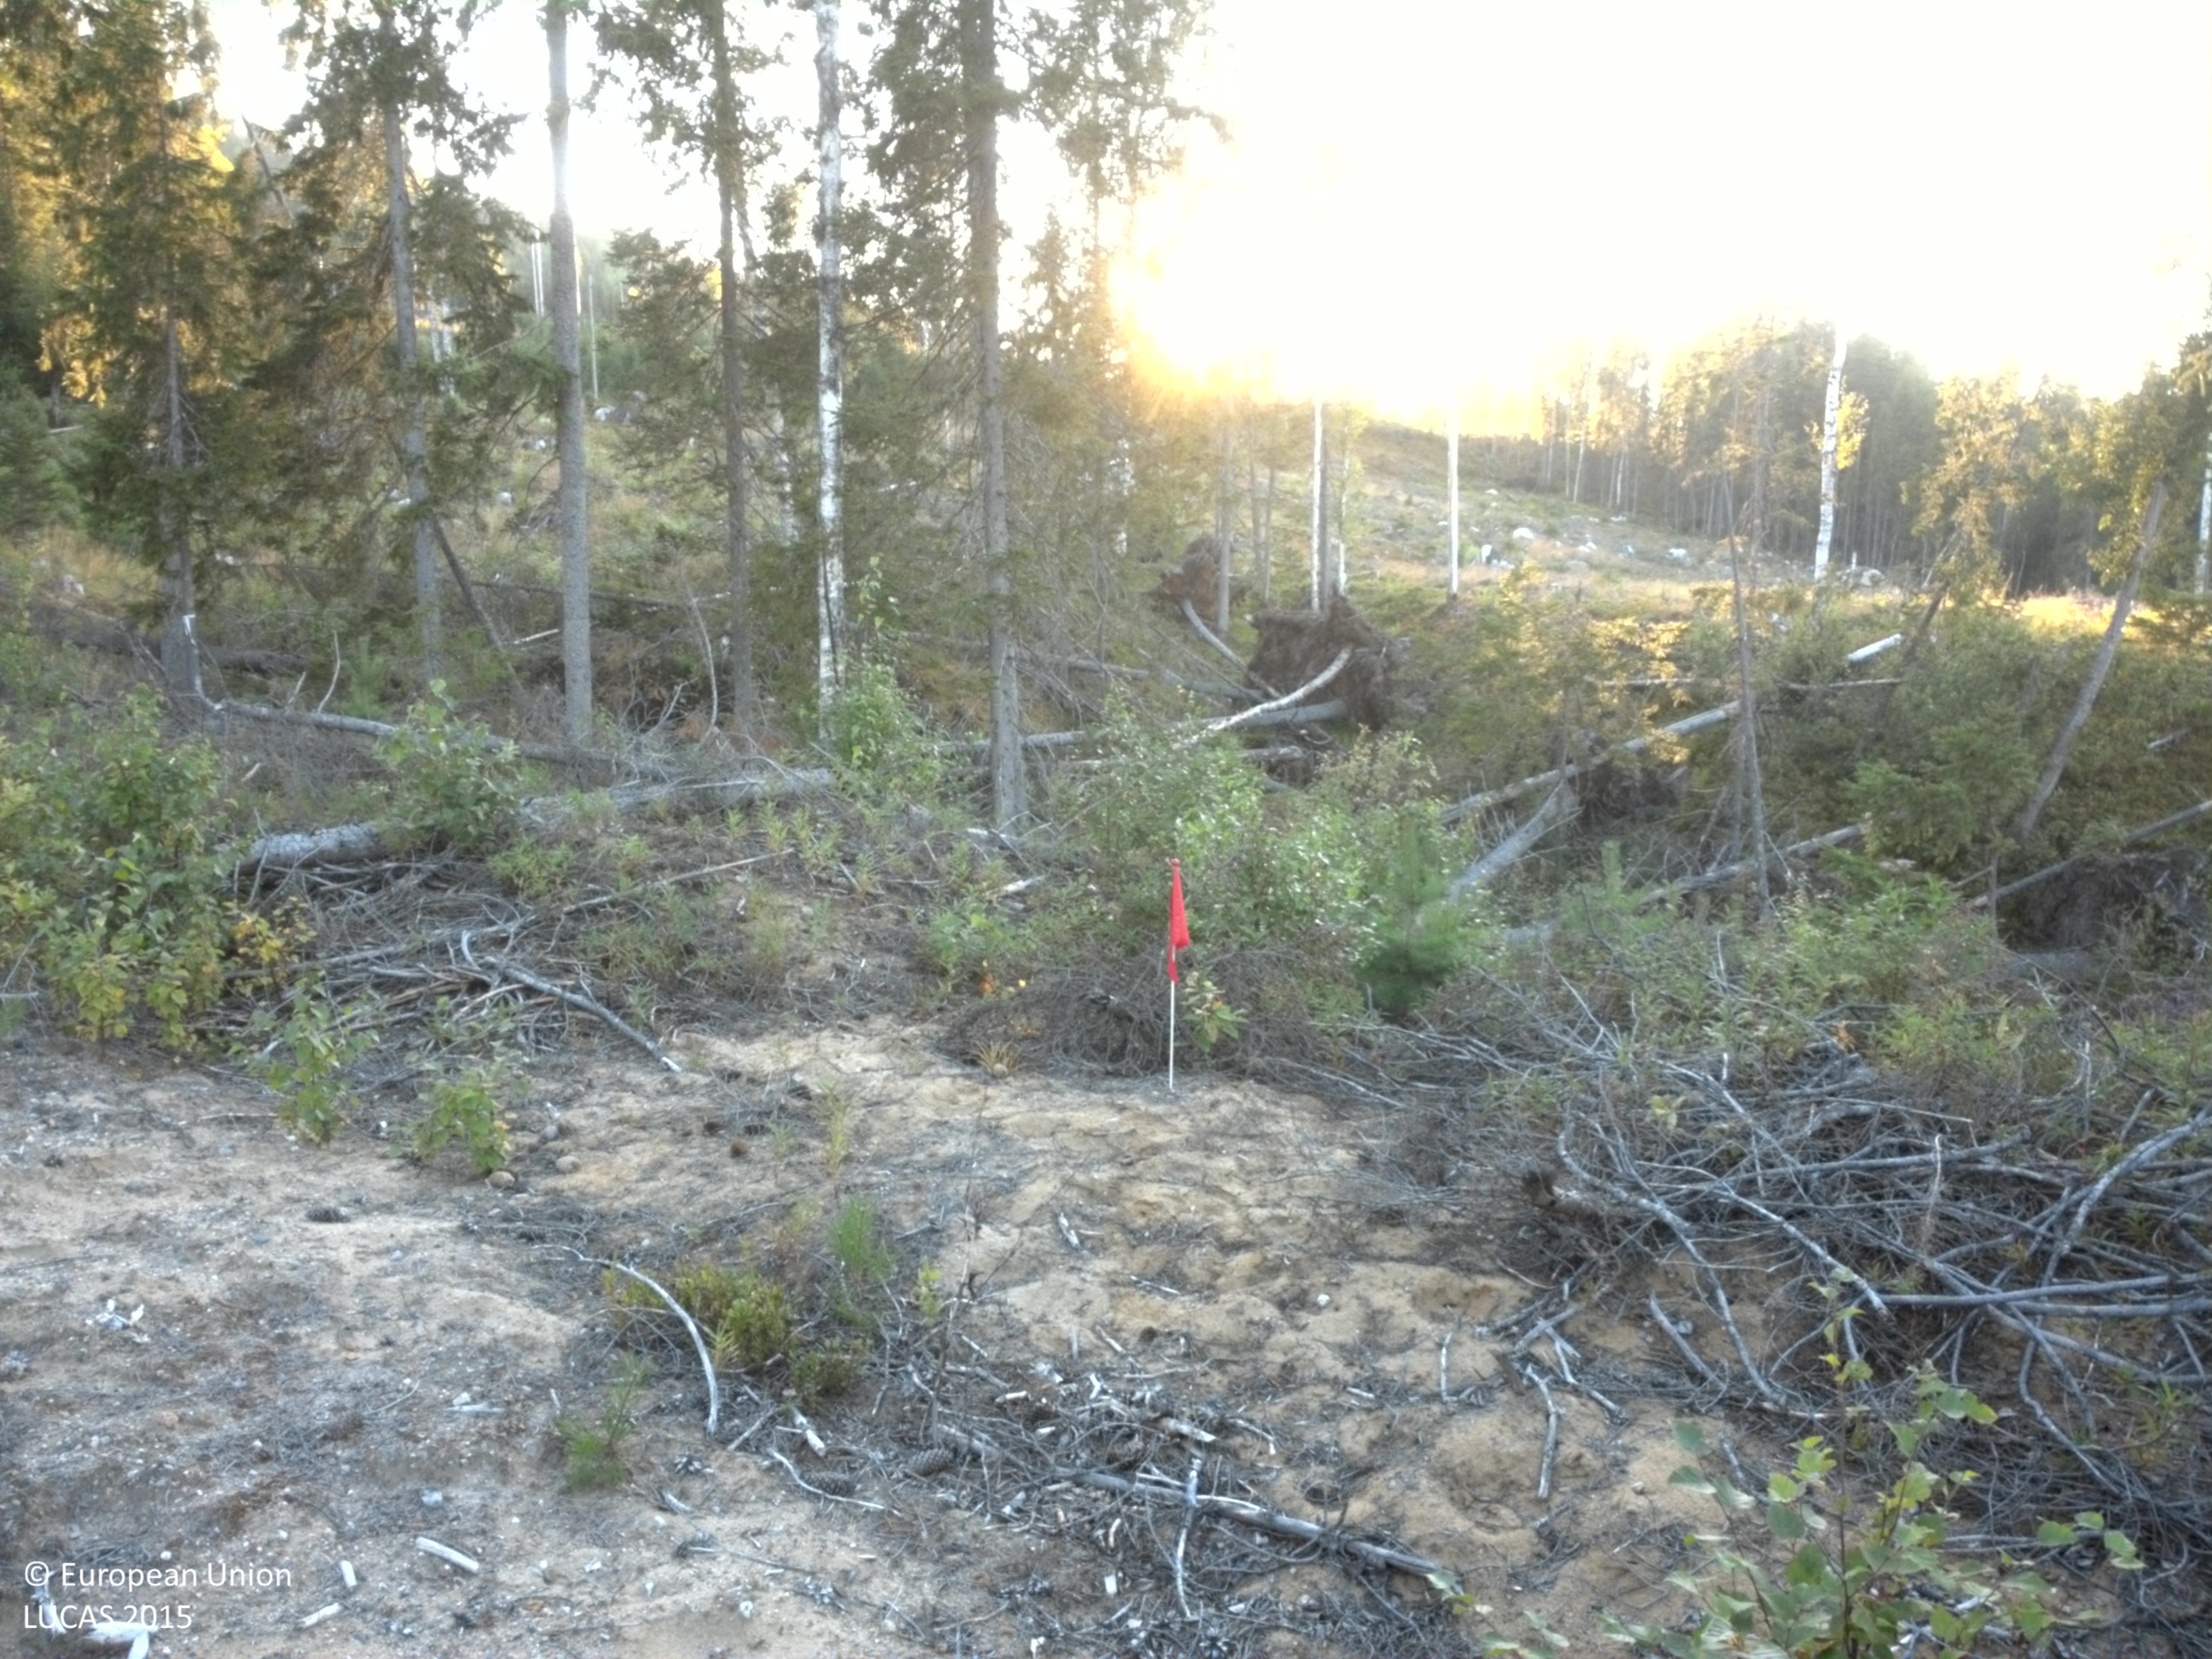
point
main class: Woodland
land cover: Other mixed woodland
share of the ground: 10 - 25 %
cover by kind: unconsolidated bare surface 60 %, herbaceous plants 20 %, broadleaved forest trees 10 %, coniferous forest trees 5 %, shrubs 5 %
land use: Forestry
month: August
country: SE
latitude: 64.4153
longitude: 18.9985
